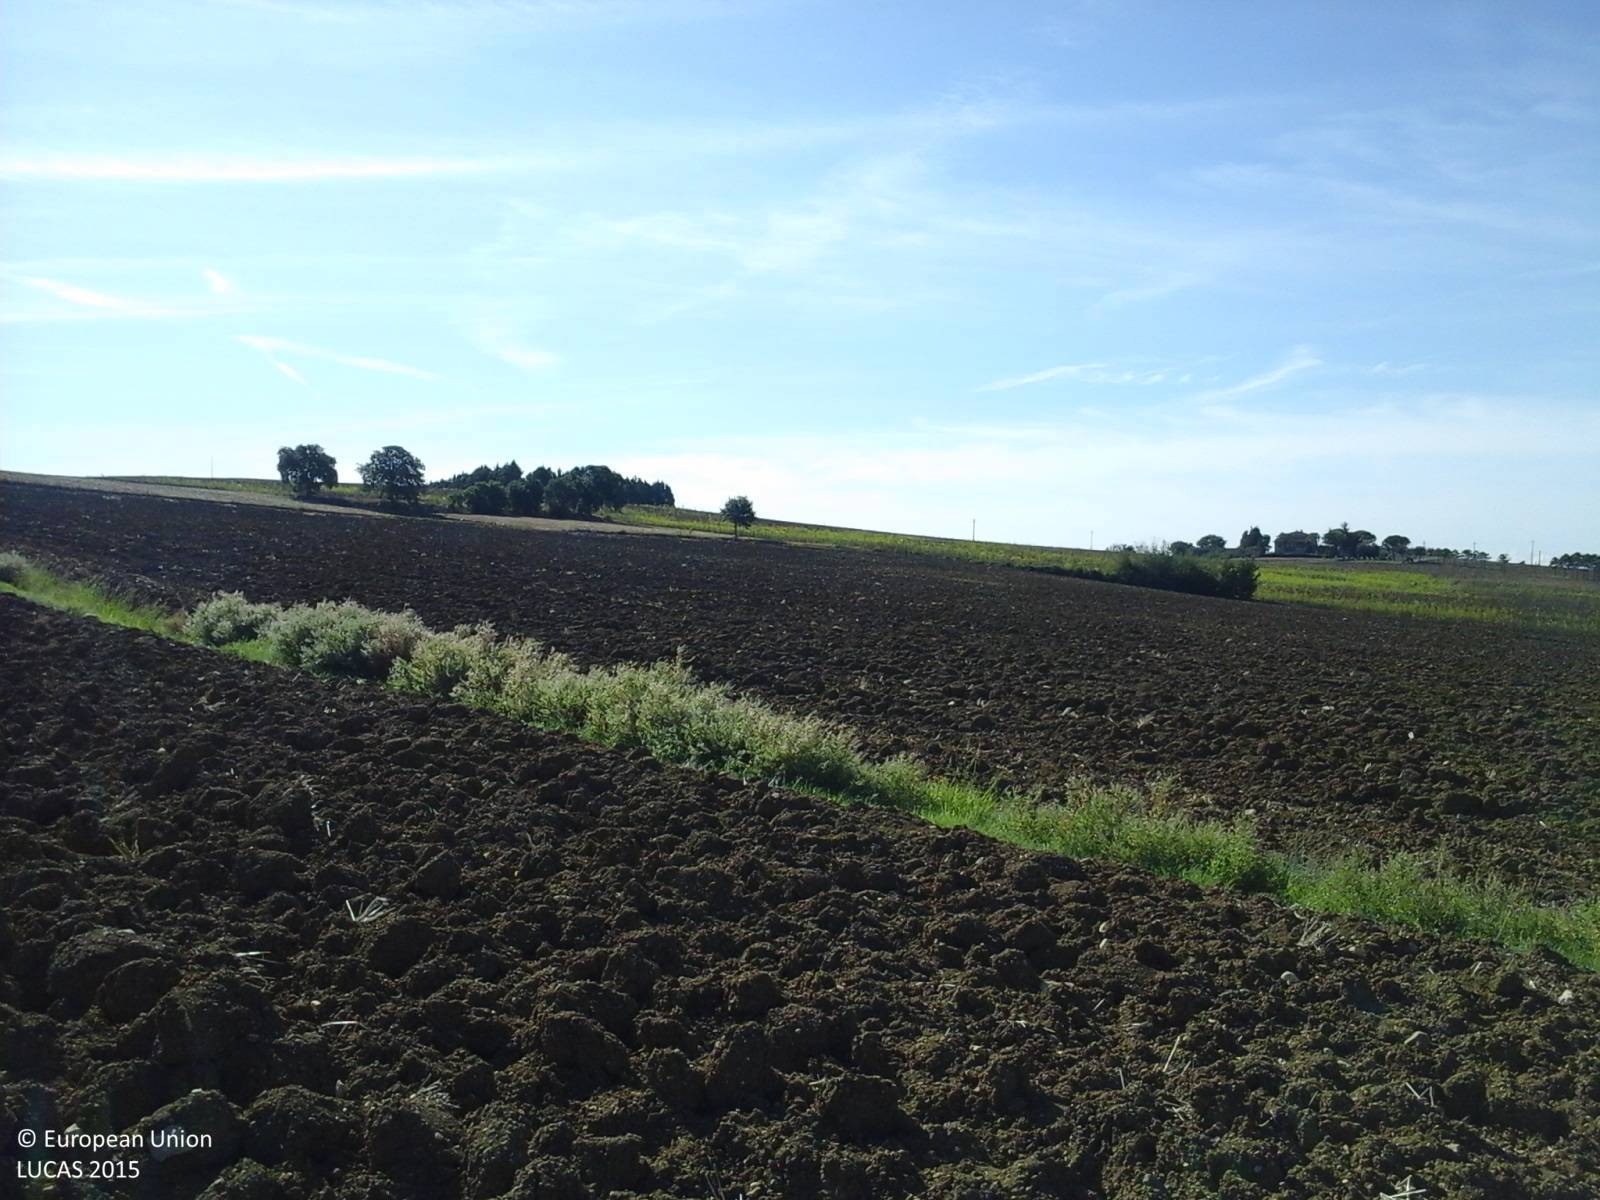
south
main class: Cropland
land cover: Common wheat
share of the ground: < 10 %
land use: Agriculture (excluding fallow land and kitchen gardens)
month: September
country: IT
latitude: 43.0251
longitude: 12.3125
